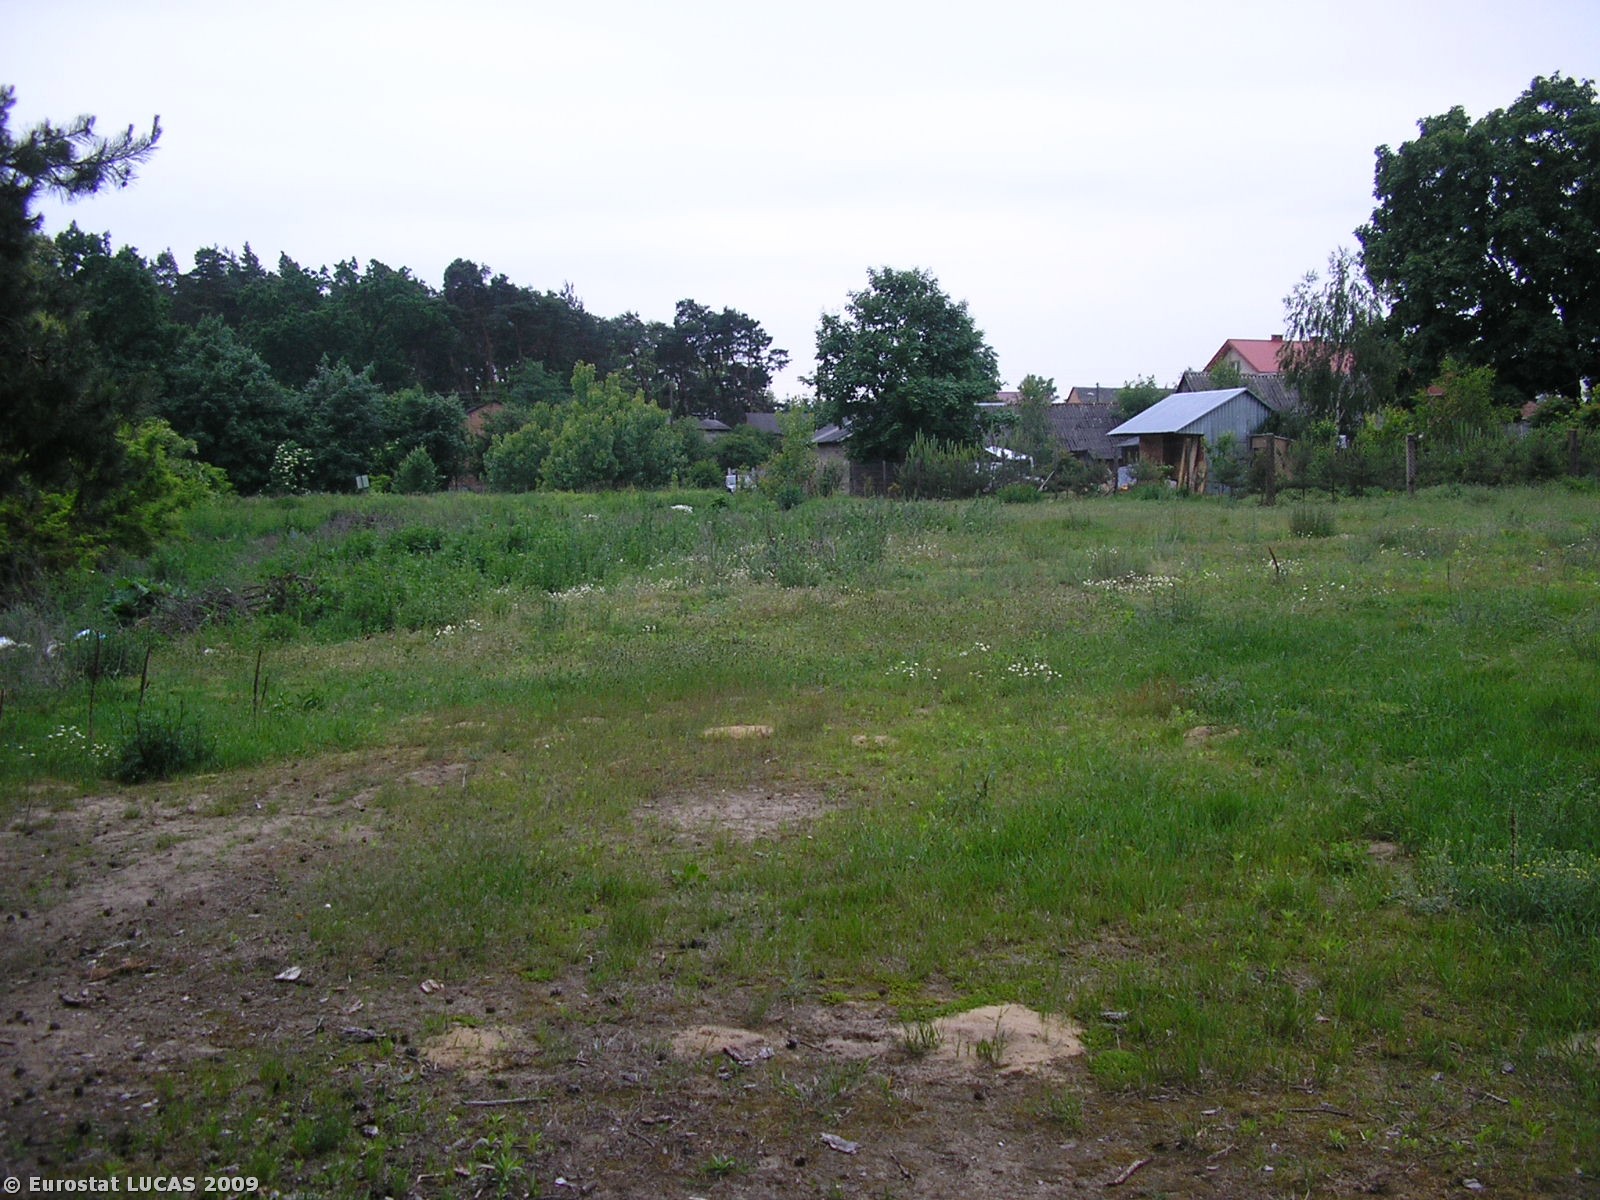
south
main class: Woodland
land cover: Coniferous woodland
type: hemiboreal forest and nemoral coniferous forest and mixed broadleaved-coniferous forest
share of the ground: 50 - 75 %
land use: Forestry
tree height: > 5 m
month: June
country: PL
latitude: 51.4948
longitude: 18.9679
